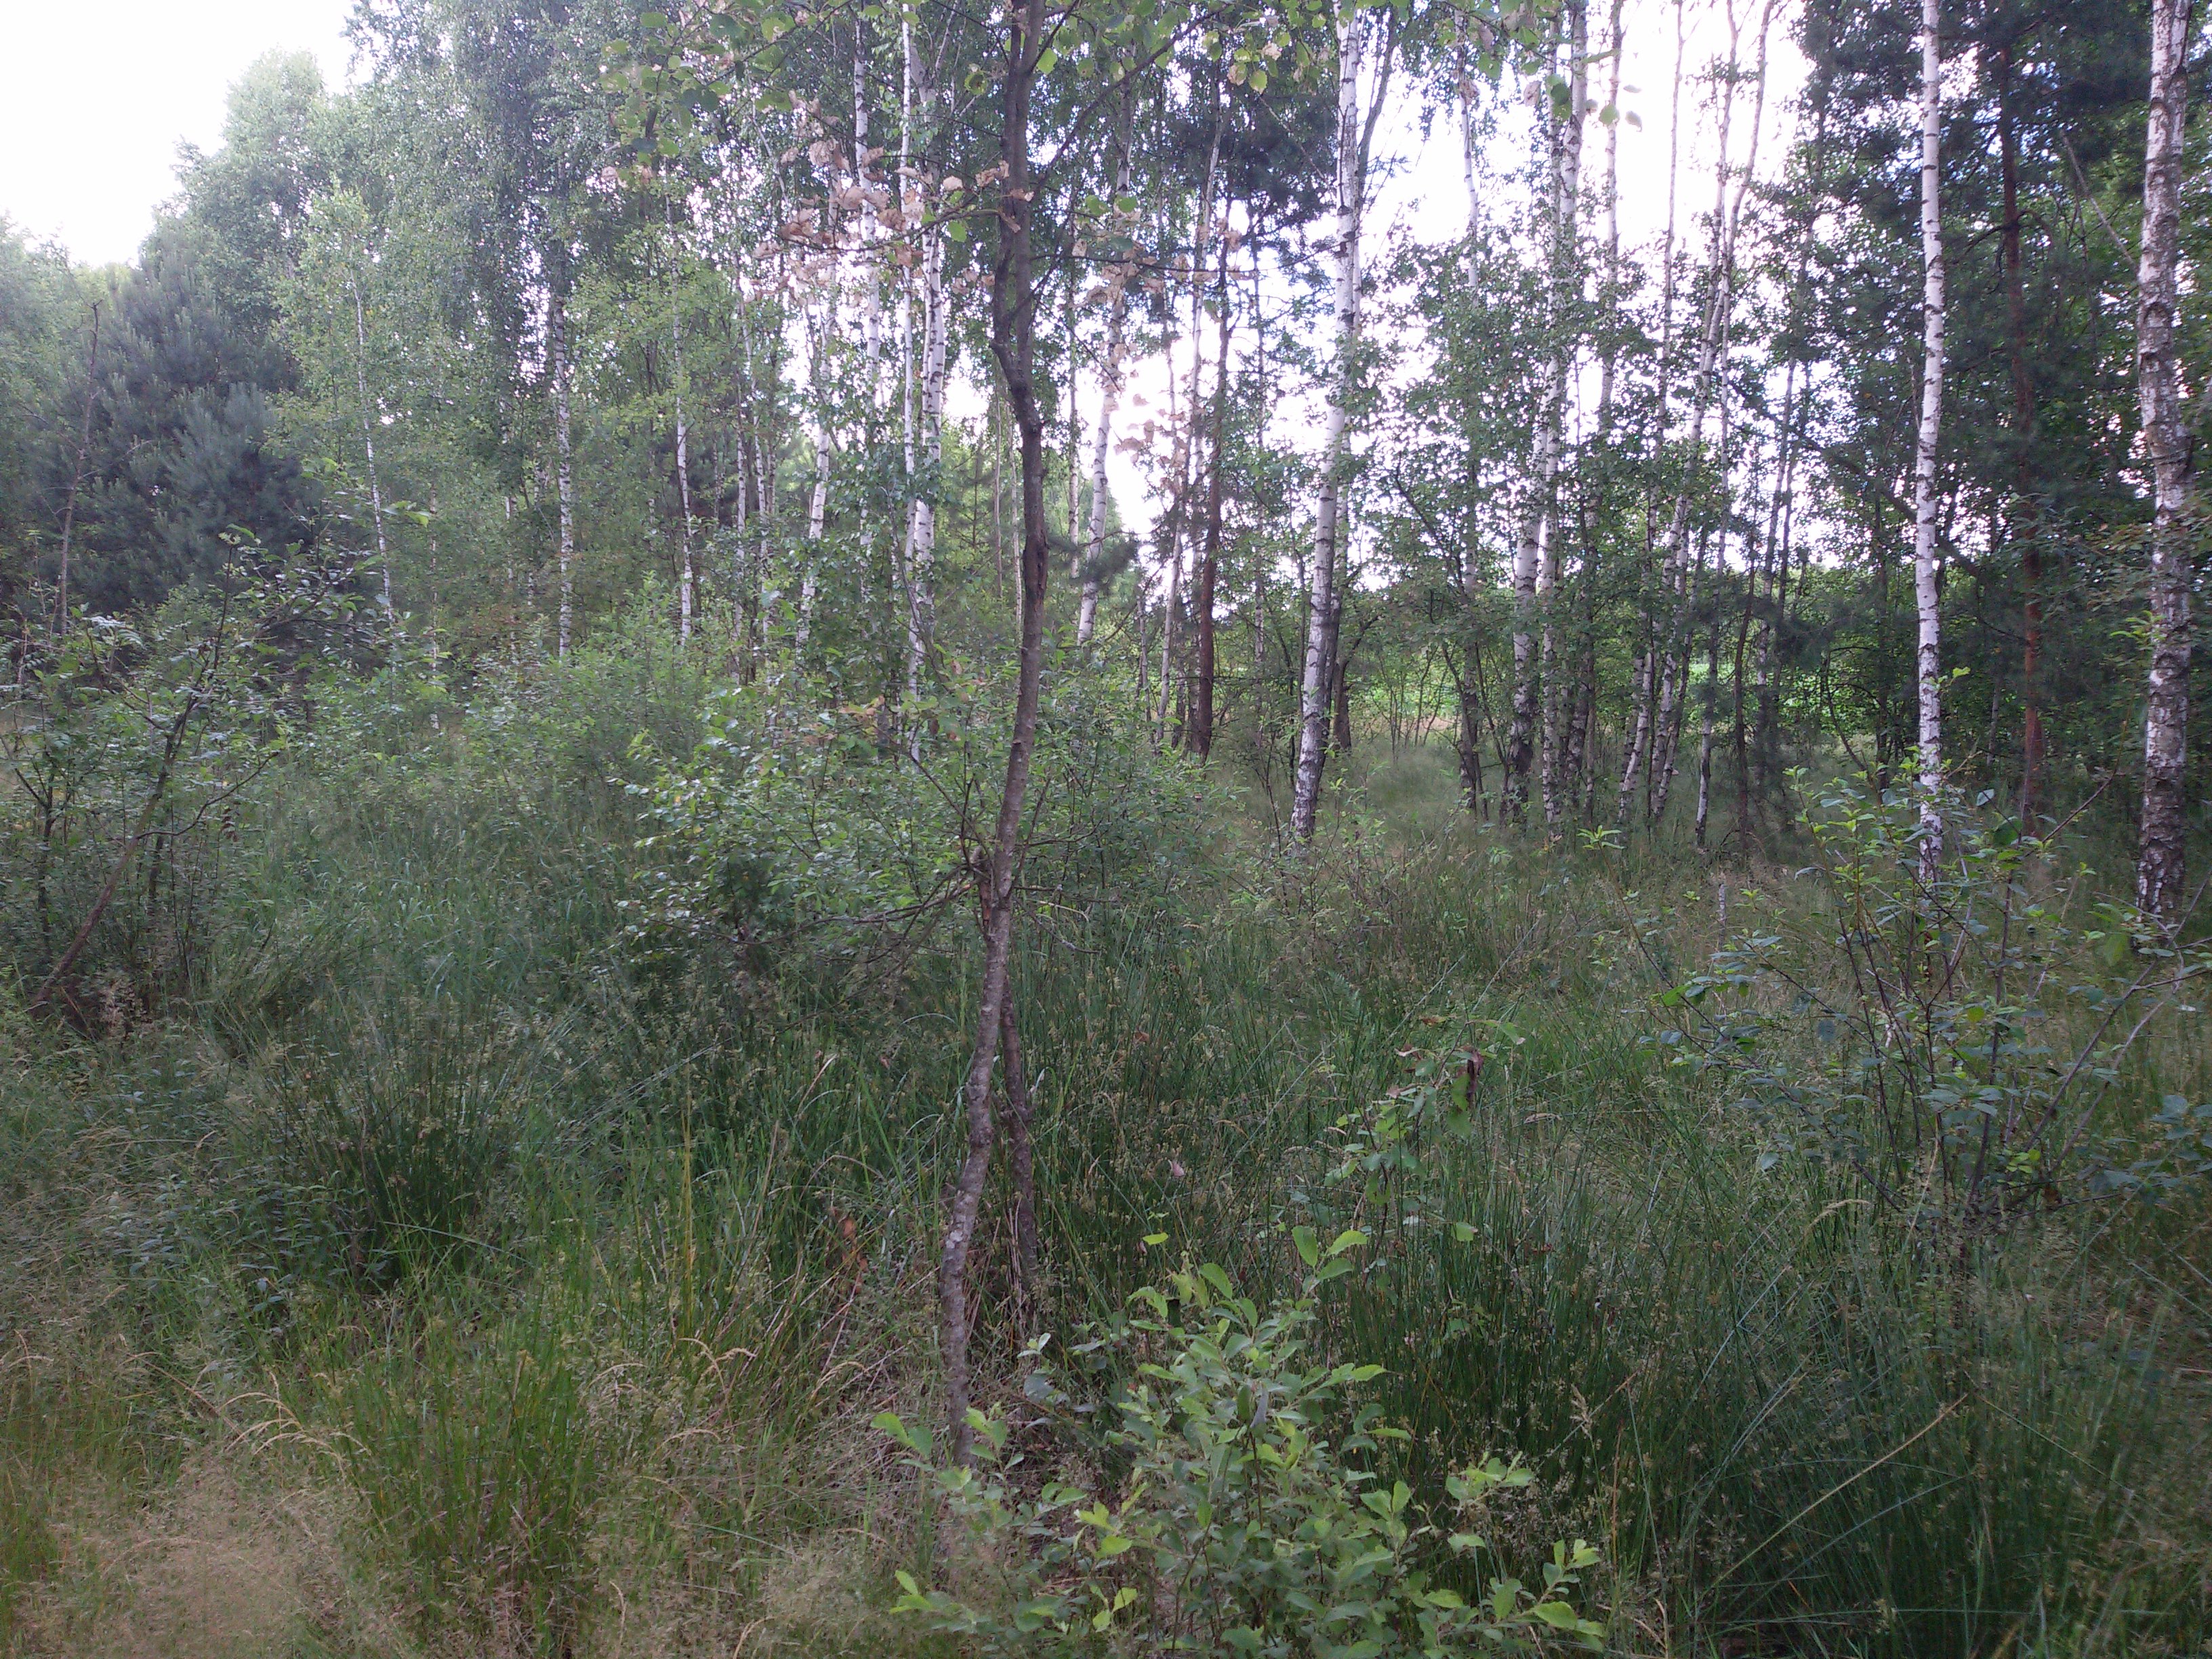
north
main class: Woodland
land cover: Broadleaved woodland
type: mesophytic deciduous forest
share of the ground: > 75 %
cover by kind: broadleaved forest trees 85 %, herbaceous plants 10 %, shrubs 5 %
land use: Forestry
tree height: > 5 m
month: June
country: PL
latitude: 51.8513
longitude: 23.0697
